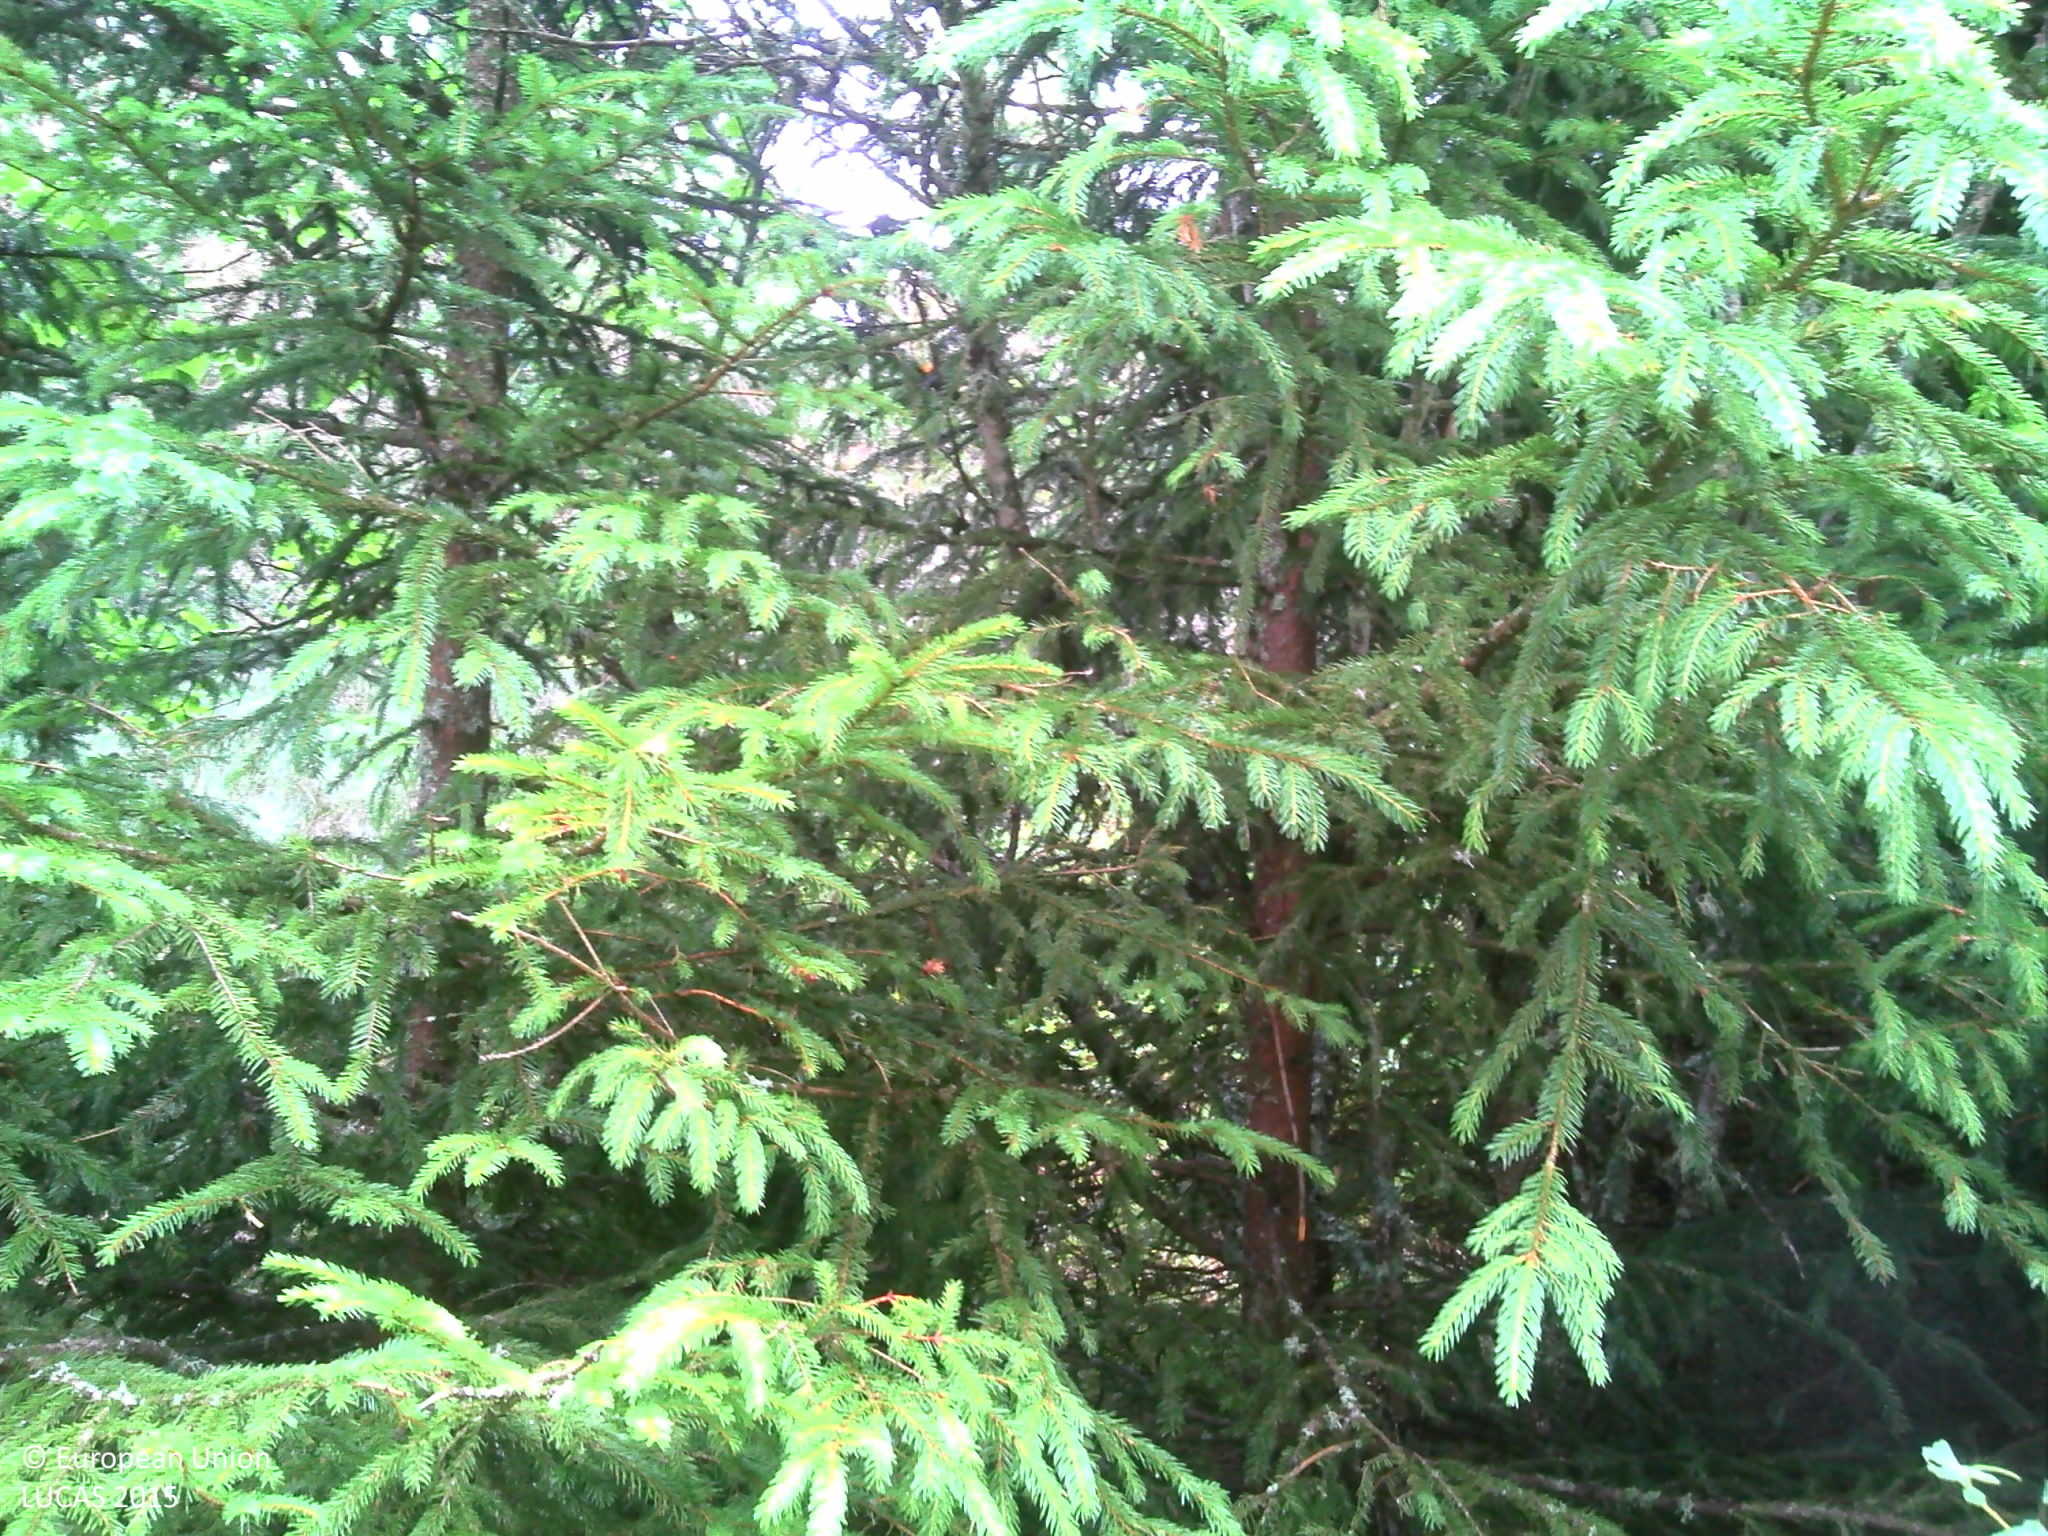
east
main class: Woodland
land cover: Spruce dominated coniferous woodland
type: alpine coniferous forest
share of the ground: > 75 %
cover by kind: coniferous forest trees 95 %, broadleaved forest trees 5 %
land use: Forestry
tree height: > 5 m
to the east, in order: Spruce dominated coniferous woodland; Tracks; Spruce dominated coniferous woodland
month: July
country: FR
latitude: 44.7451
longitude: 3.5252
